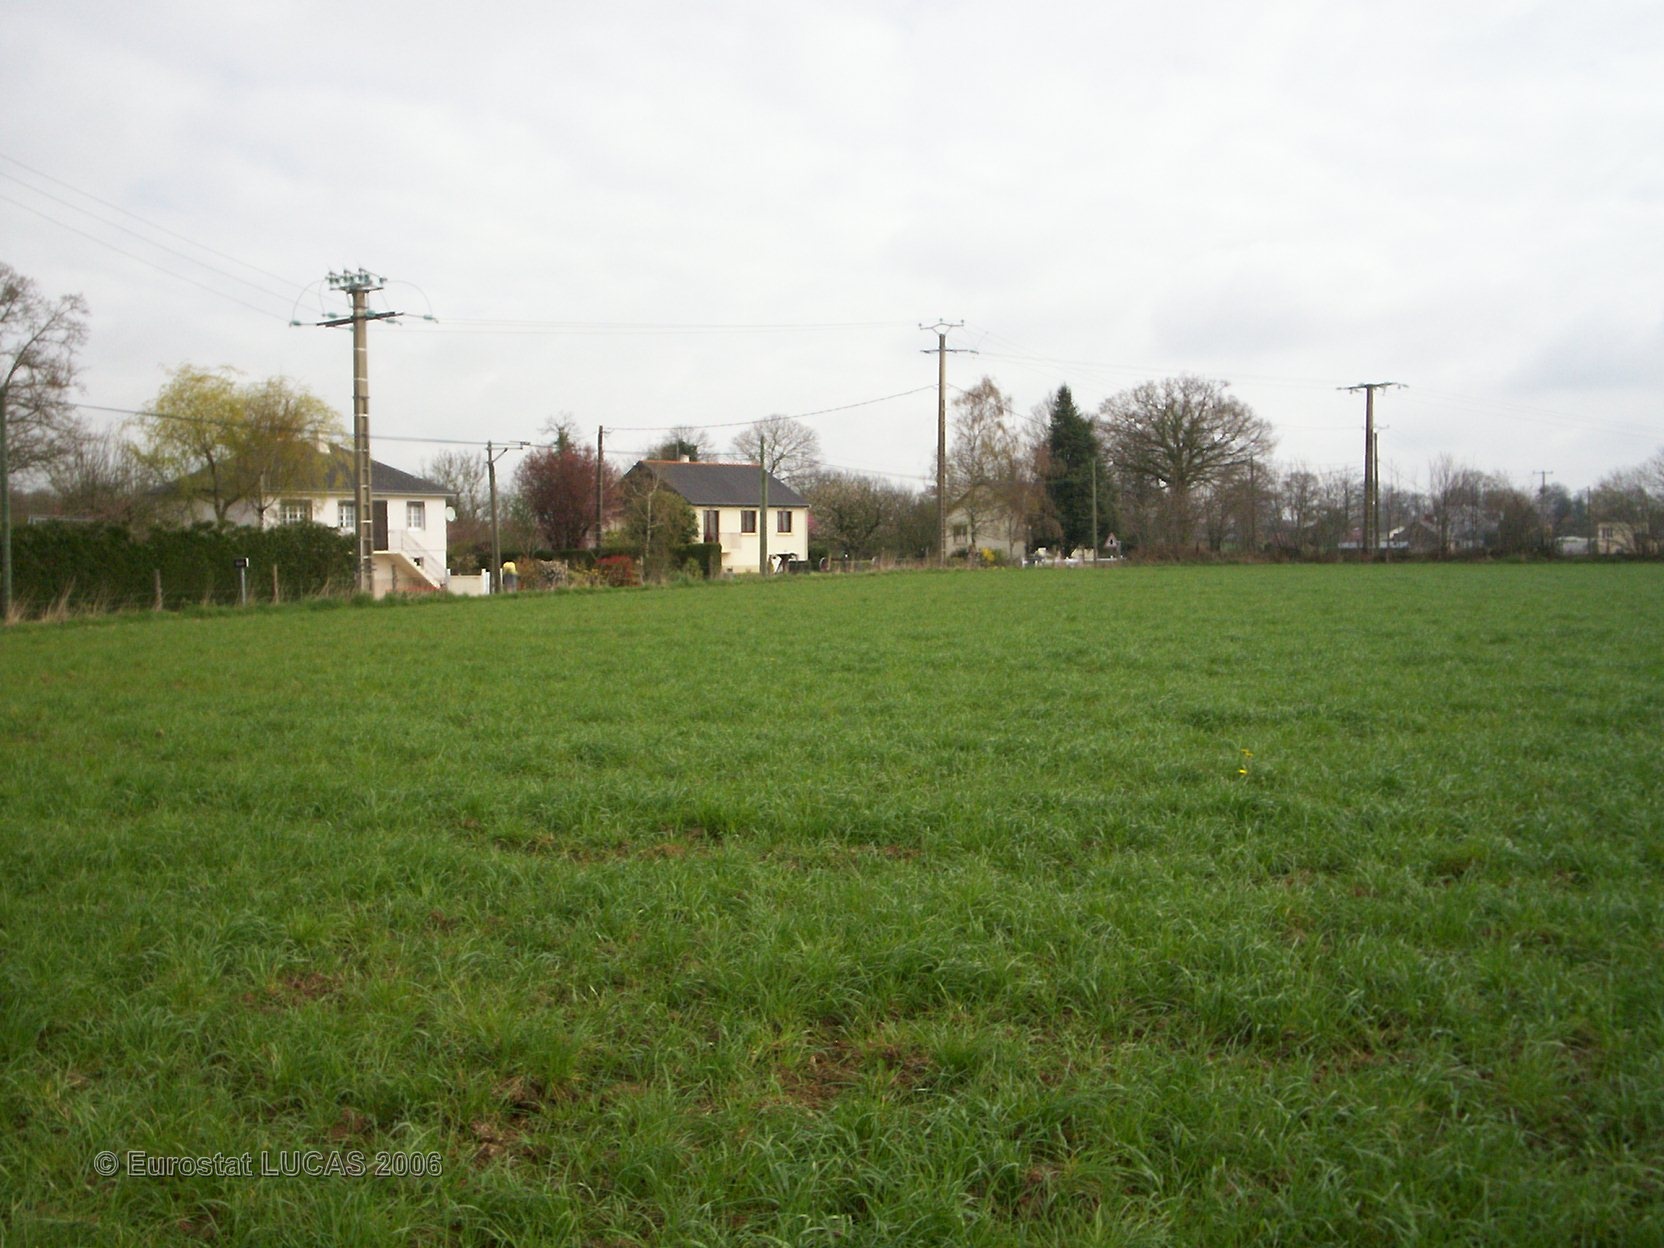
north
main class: Grassland
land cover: Grassland without tree/shrub cover
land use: Agriculture (excluding fallow land and kitchen gardens)
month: April
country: FR
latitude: 48.0924
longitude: -1.1447
